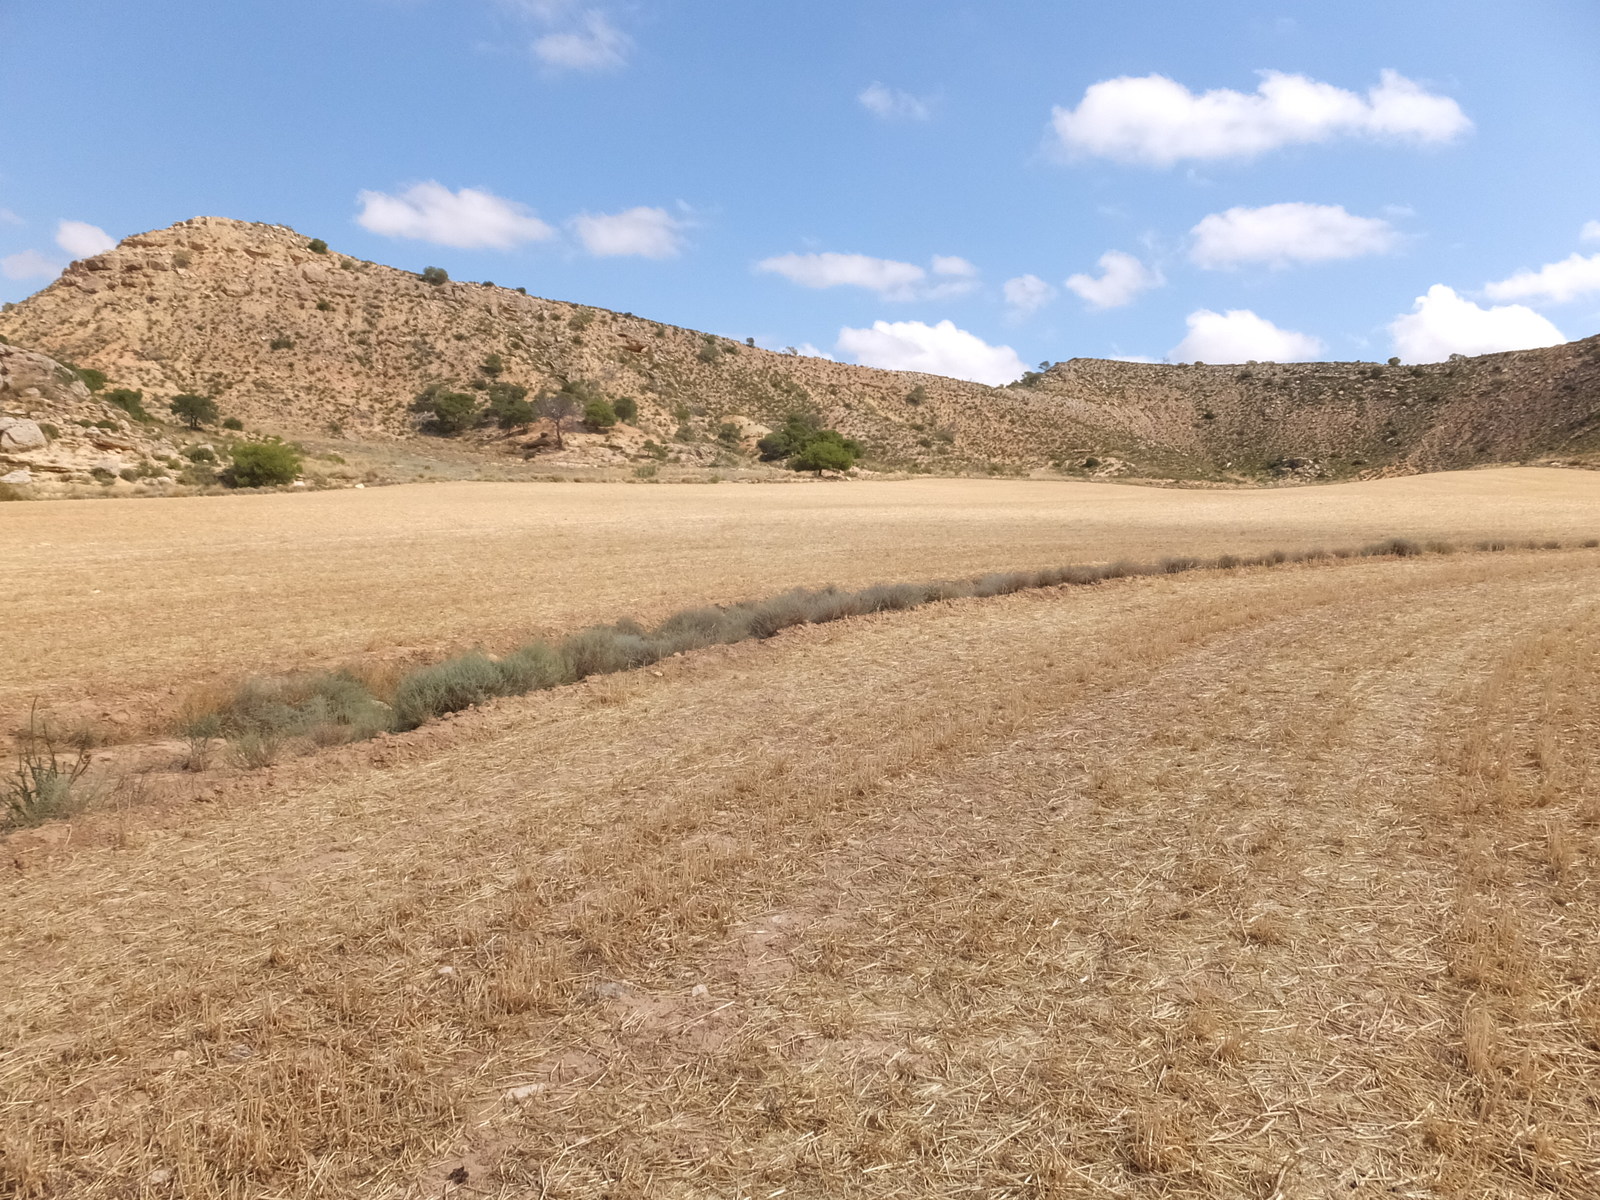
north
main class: Cropland
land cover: Barley
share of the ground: < 10 %
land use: Agriculture (excluding fallow land and kitchen gardens)
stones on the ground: < 10 %
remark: Harvested field
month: June
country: ES
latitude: 41.3306
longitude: -0.0861
